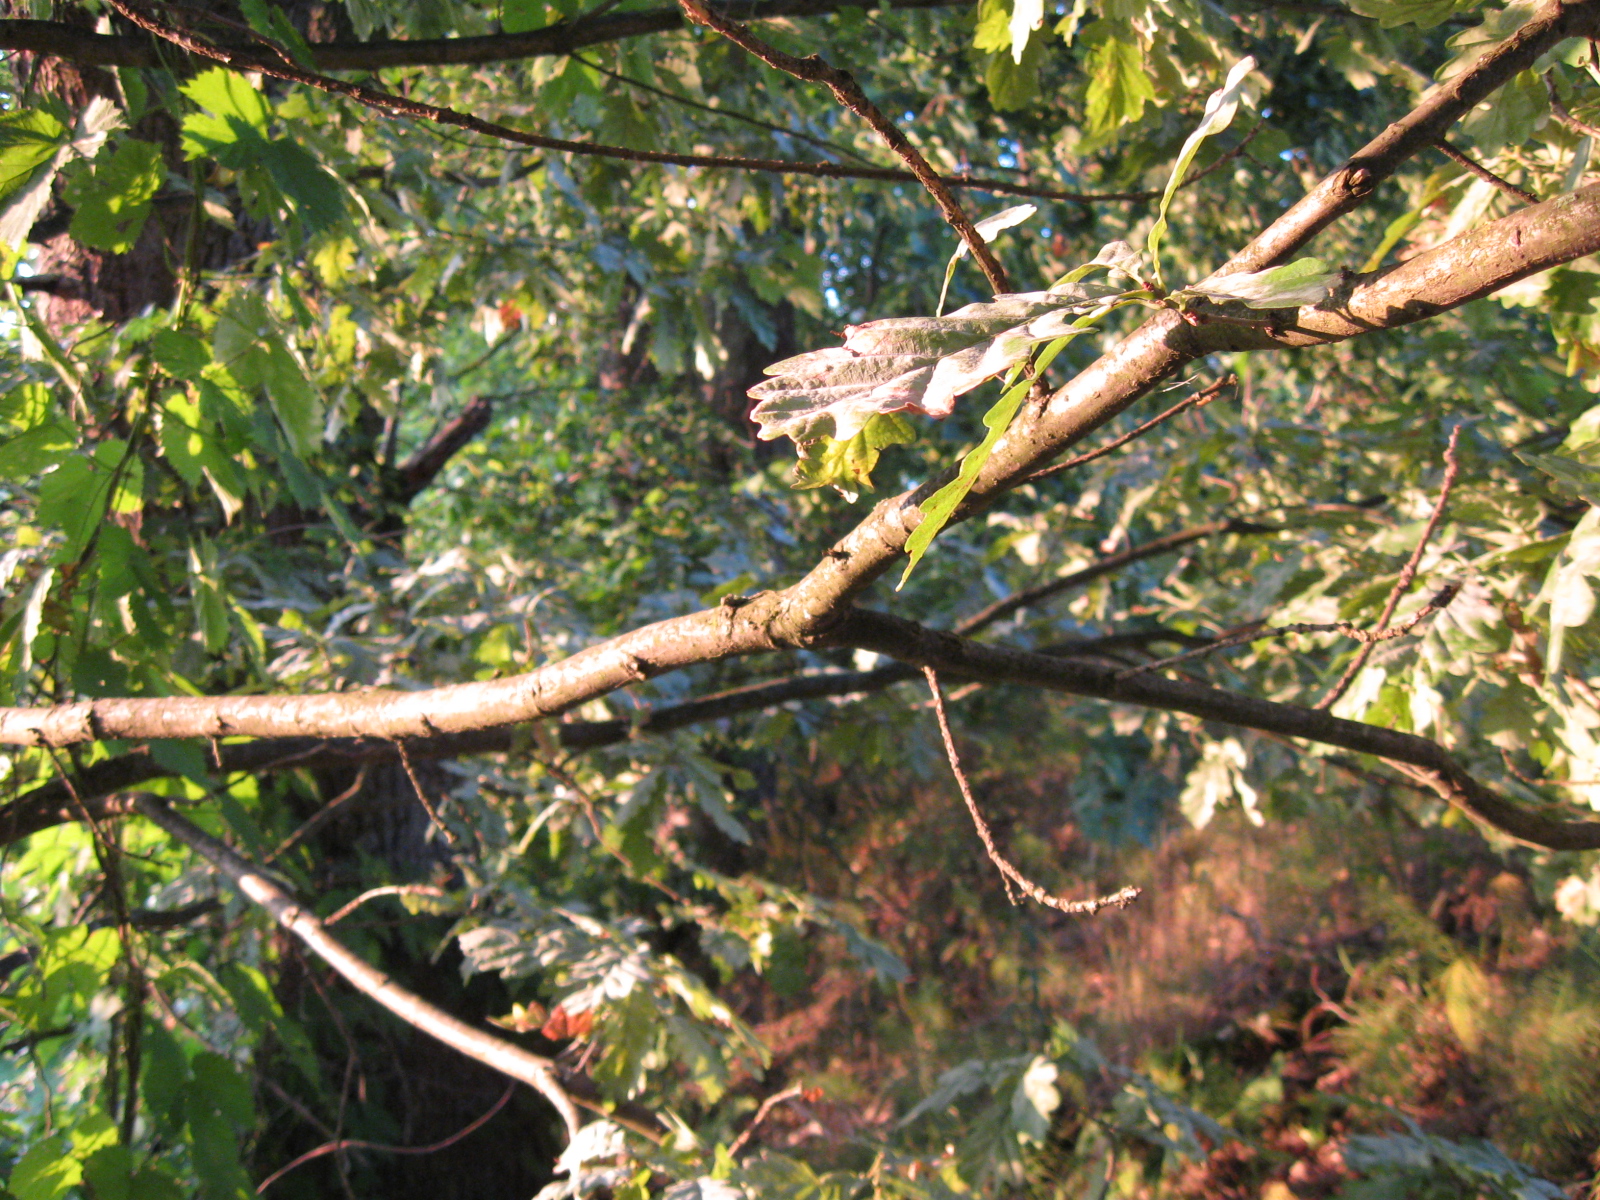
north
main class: Grassland
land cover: Grassland with sparse tree/shrub cover
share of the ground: > 75 %
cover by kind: herbaceous plants 85 %, shrubs 10 %, broadleaved forest trees 5 %
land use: Semi-natural and natural areas not in use
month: August
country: LT
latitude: 54.7027
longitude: 23.5049
